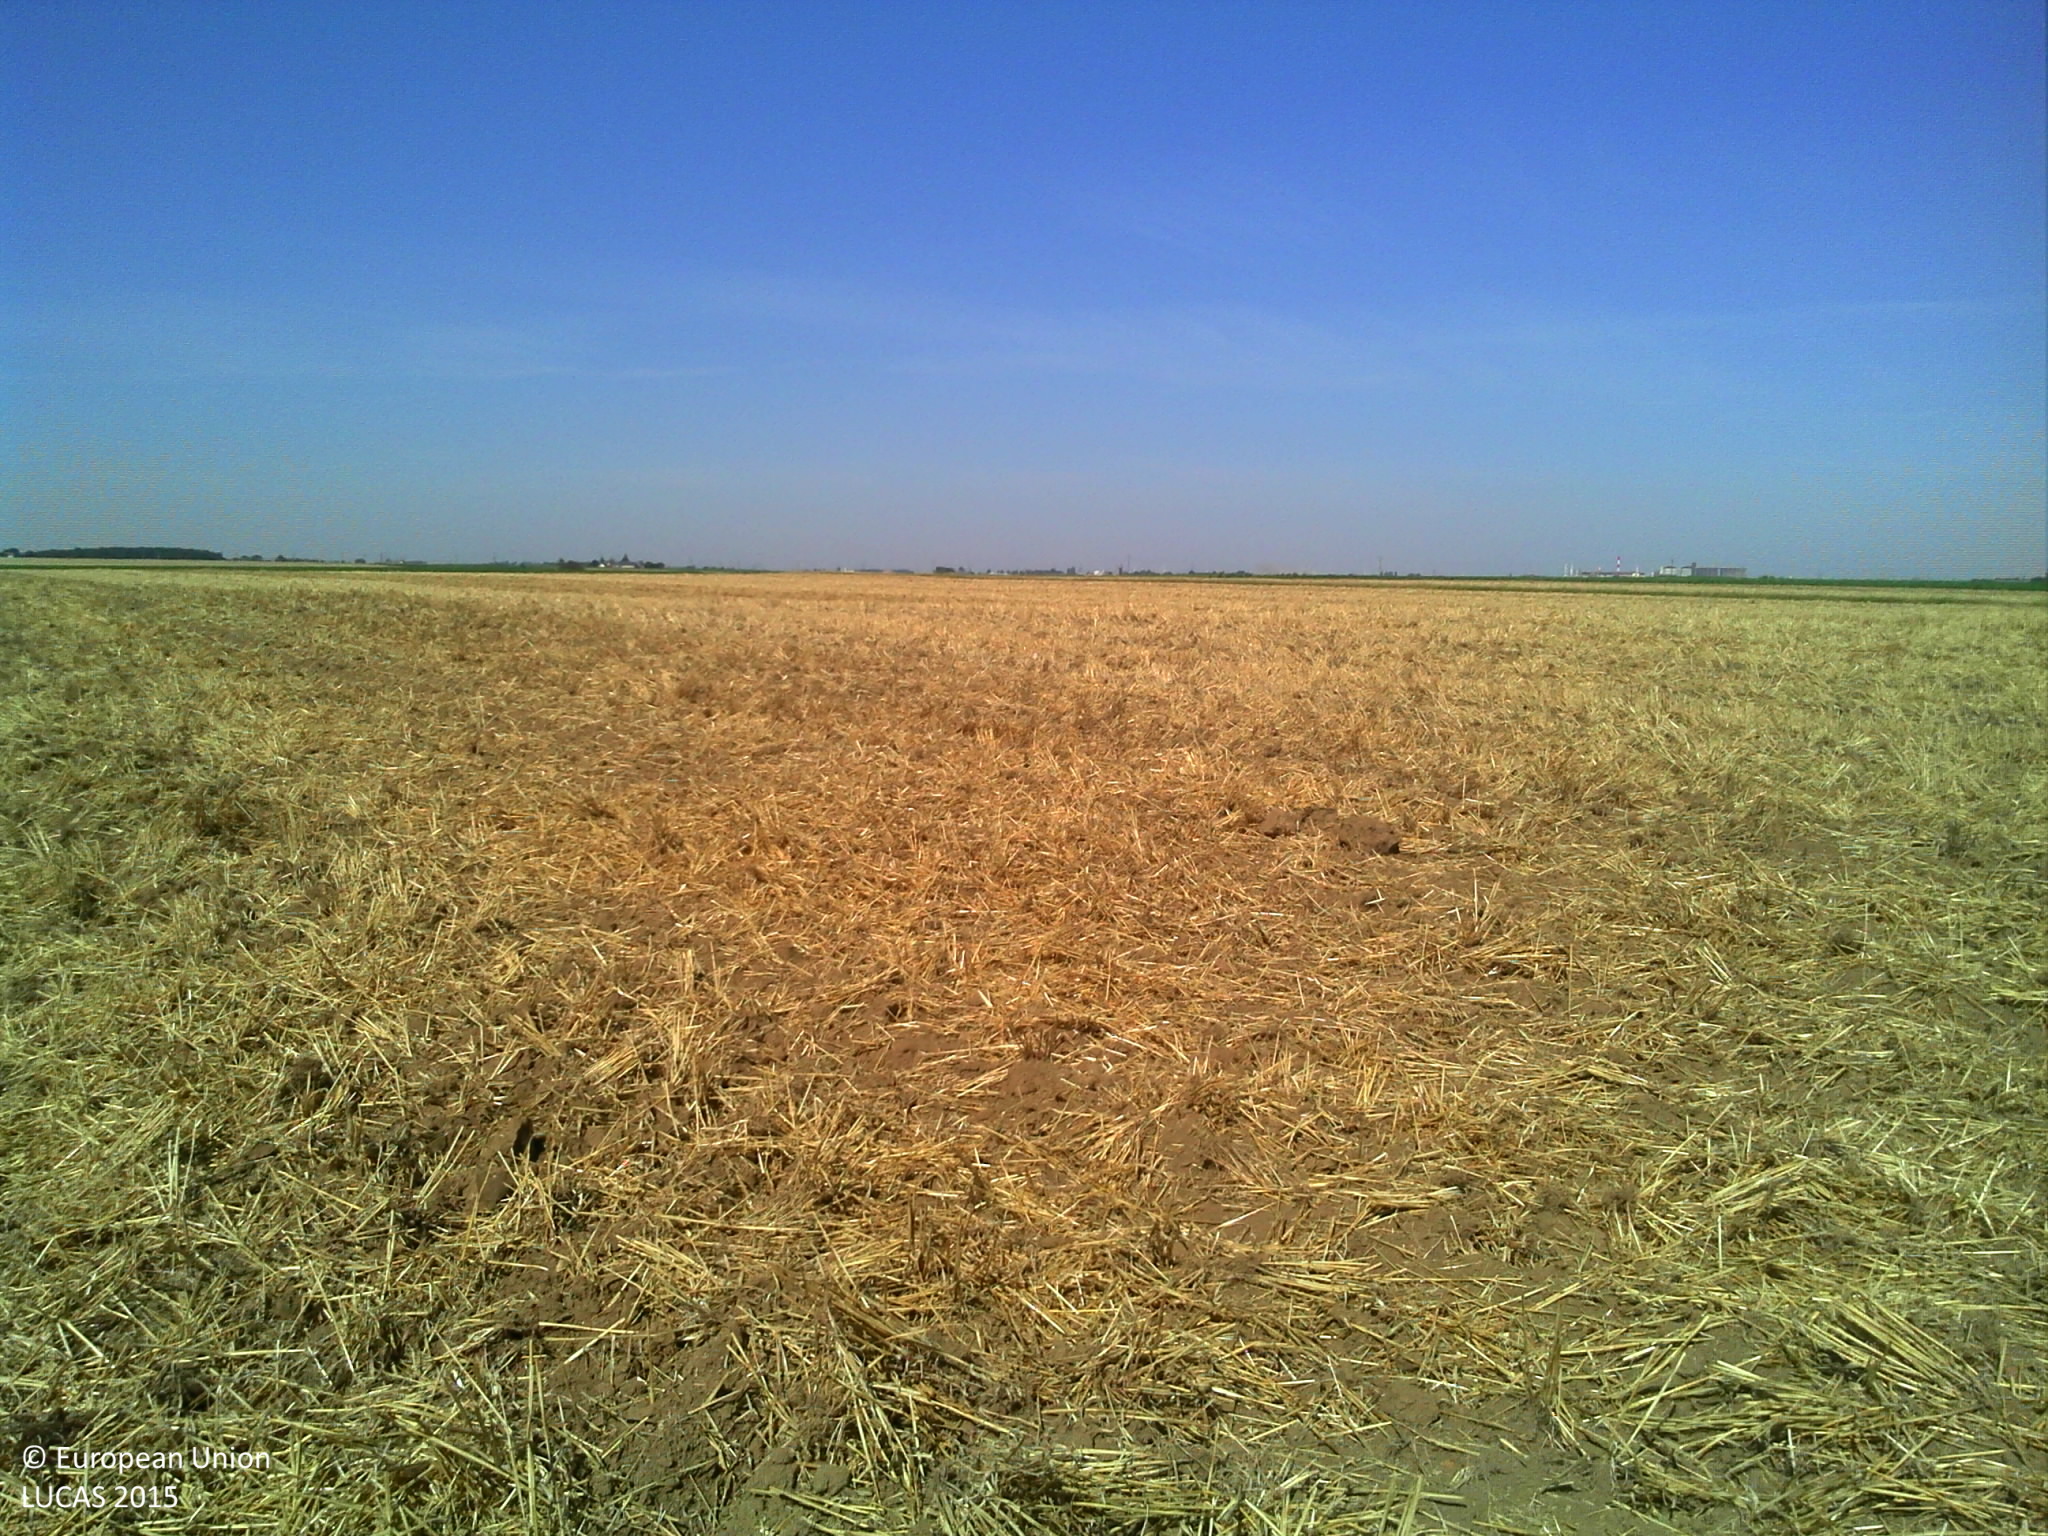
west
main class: Cropland
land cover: Common wheat
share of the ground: > 75 %
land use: Agriculture (excluding fallow land and kitchen gardens)
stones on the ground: < 10 %
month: August
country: FR
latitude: 48.0733
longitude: 1.9477
